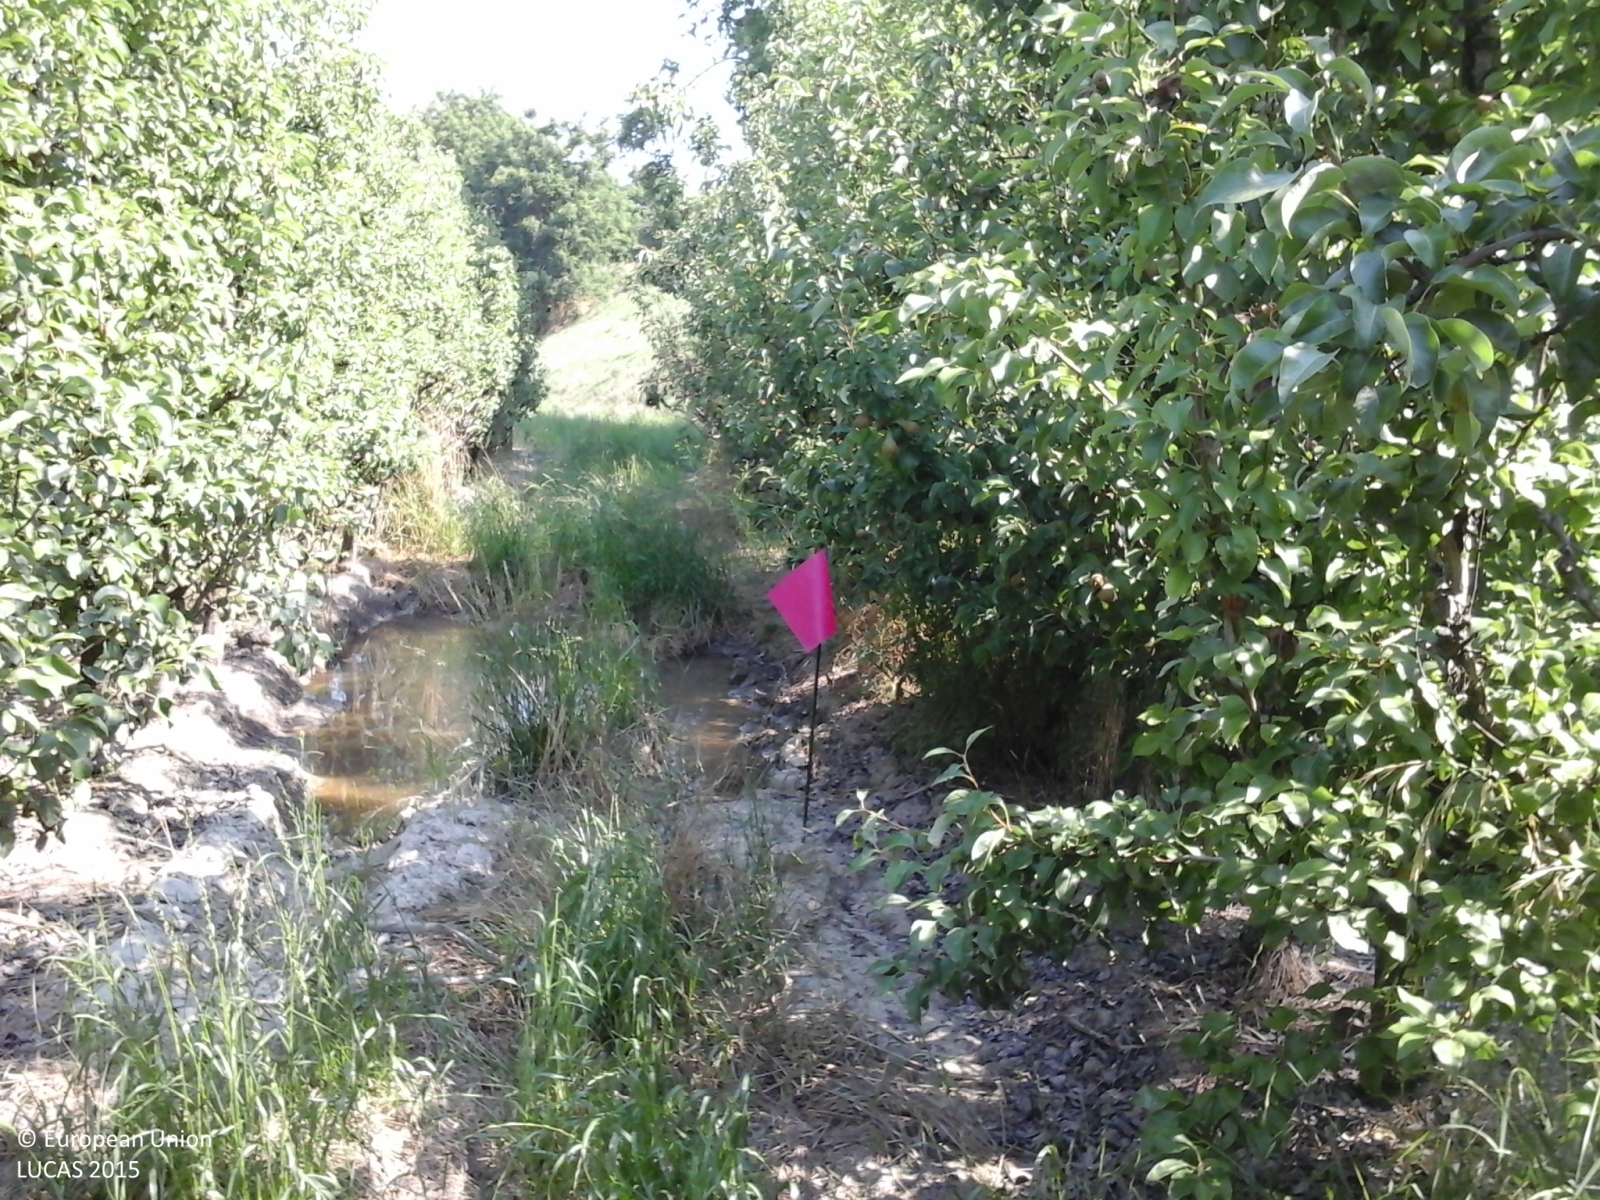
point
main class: Cropland
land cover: Pear fruit
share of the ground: 25 - 50 %
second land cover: Grassland without tree/shrub cover
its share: 25 - 50 %
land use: Agriculture (excluding fallow land and kitchen gardens)
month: June
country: IT
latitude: 44.6429
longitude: 11.7237
